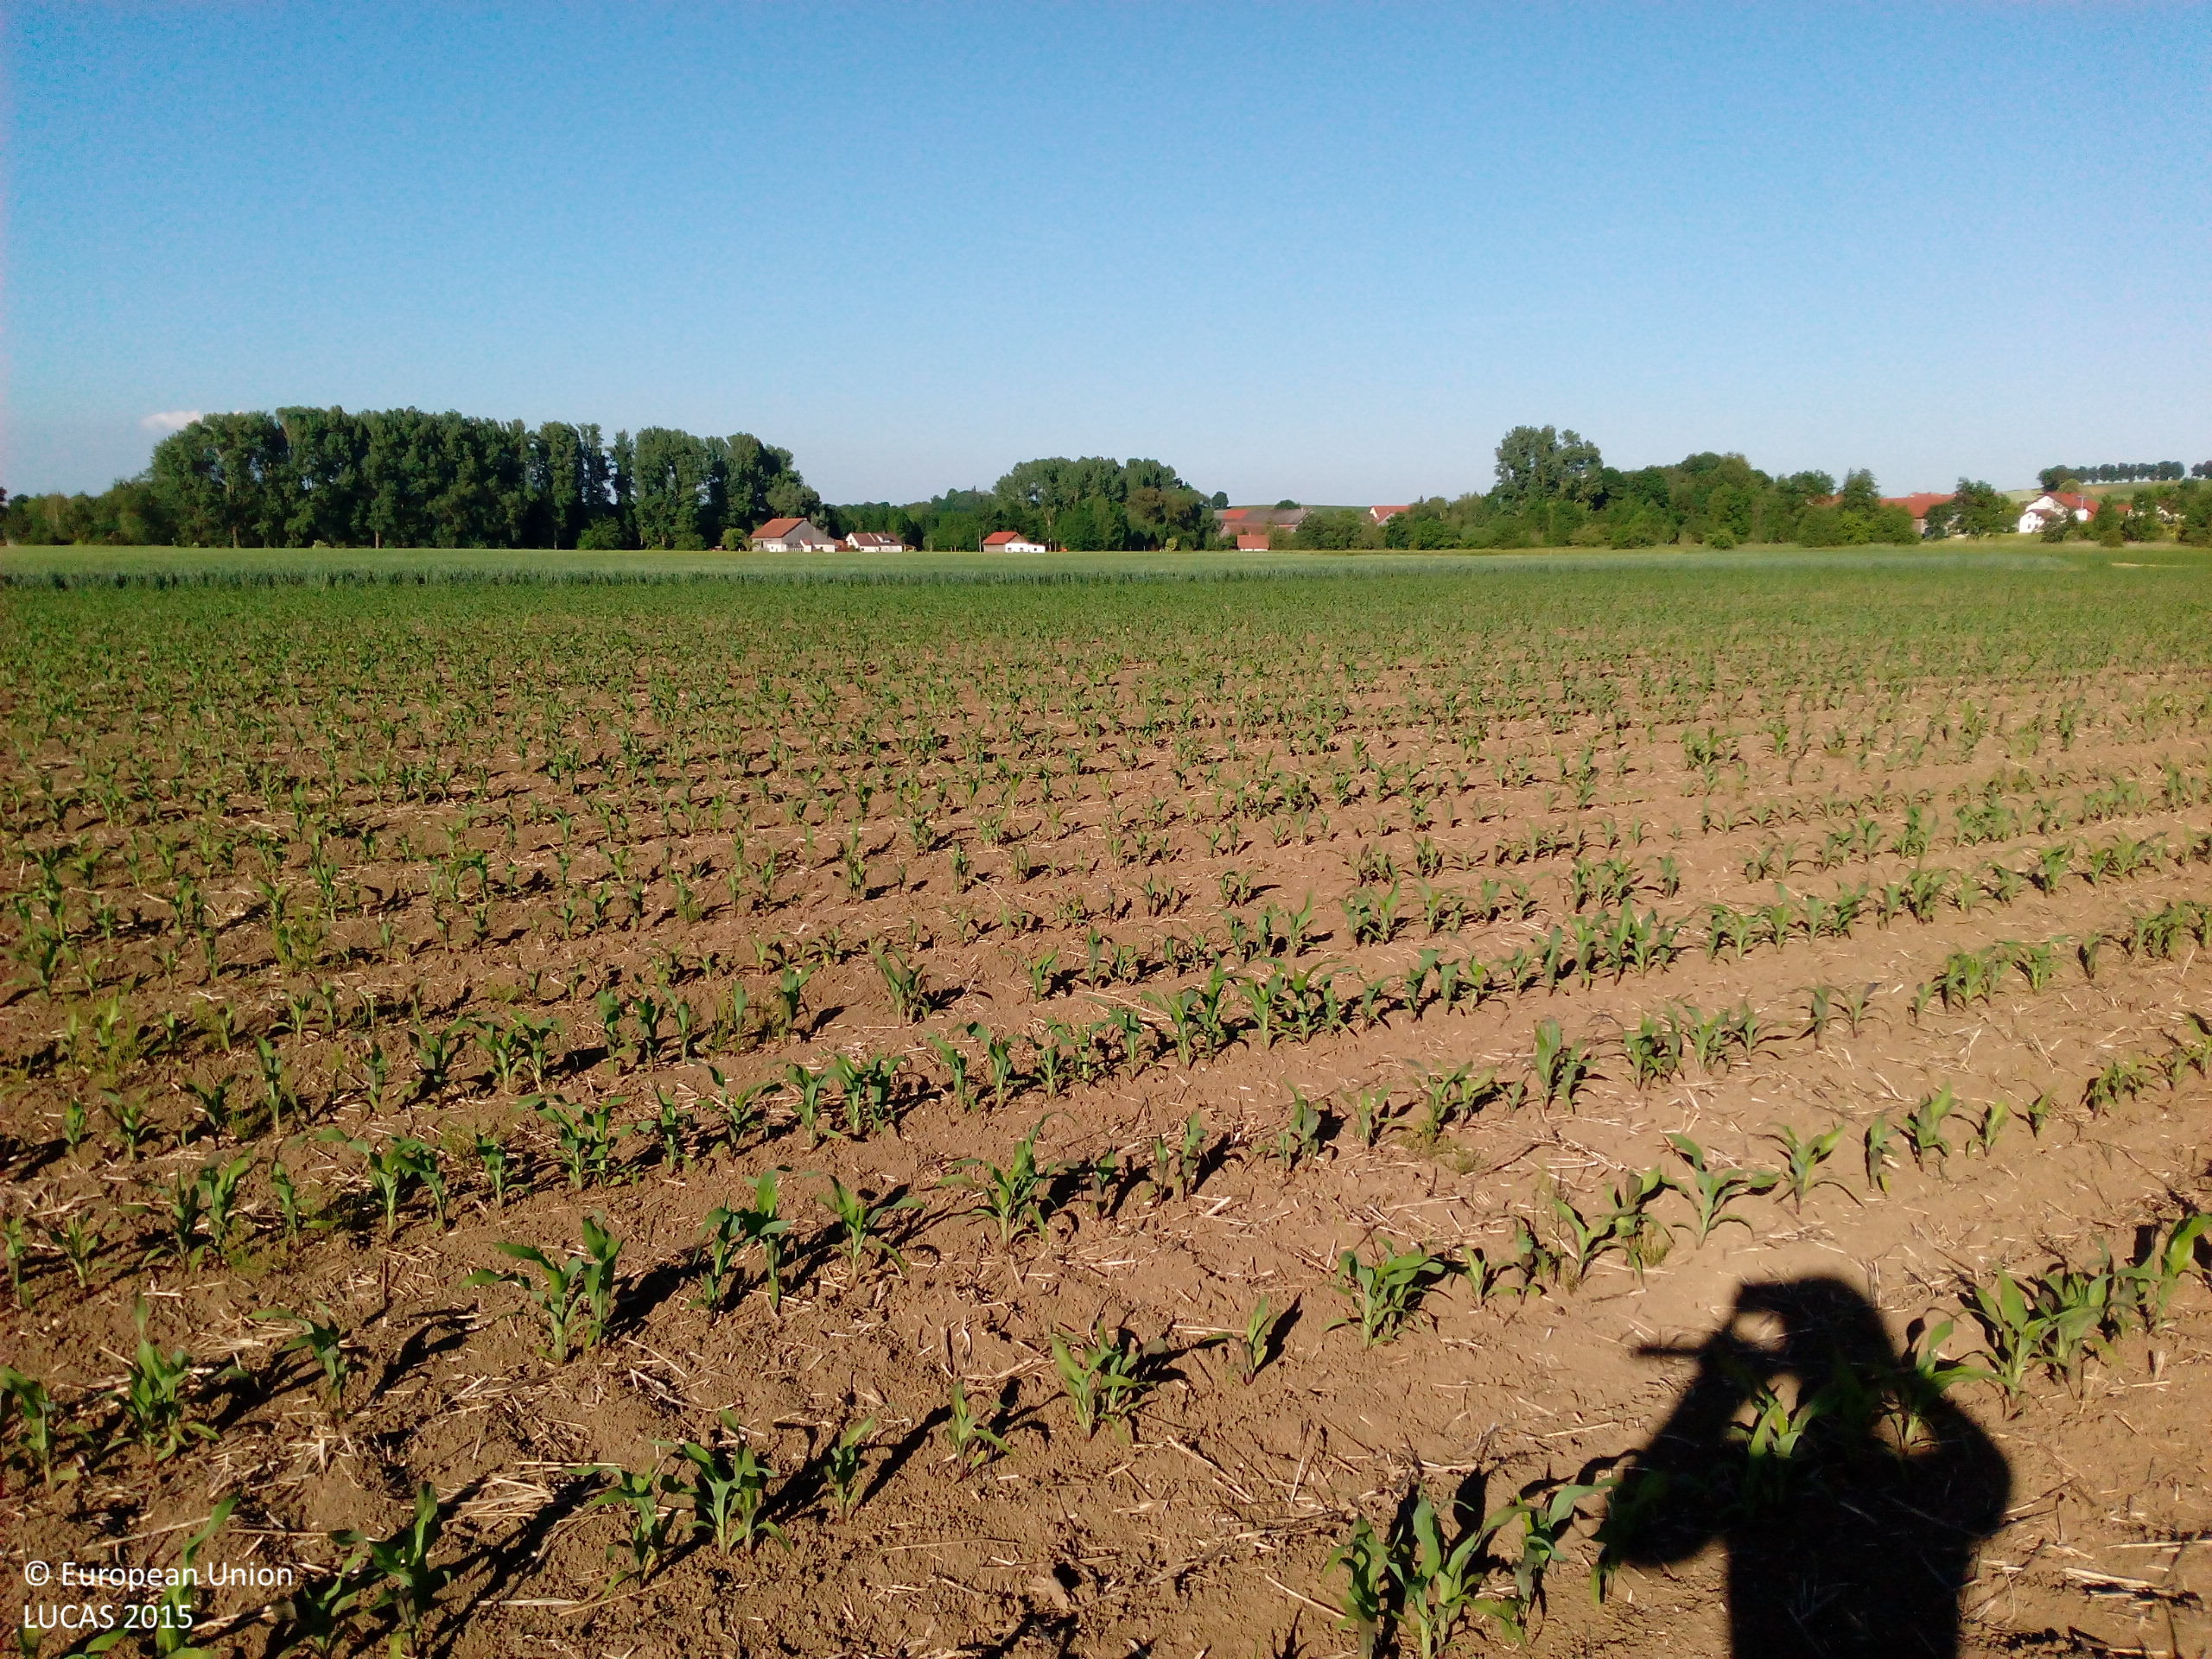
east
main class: Cropland
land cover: Maize
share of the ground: < 10 %
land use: Agriculture (excluding fallow land and kitchen gardens)
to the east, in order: Maize; Common wheat; Grass margins; Tracks; Grass margins; Maize
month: June
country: DE
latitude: 48.8452
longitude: 12.4112
